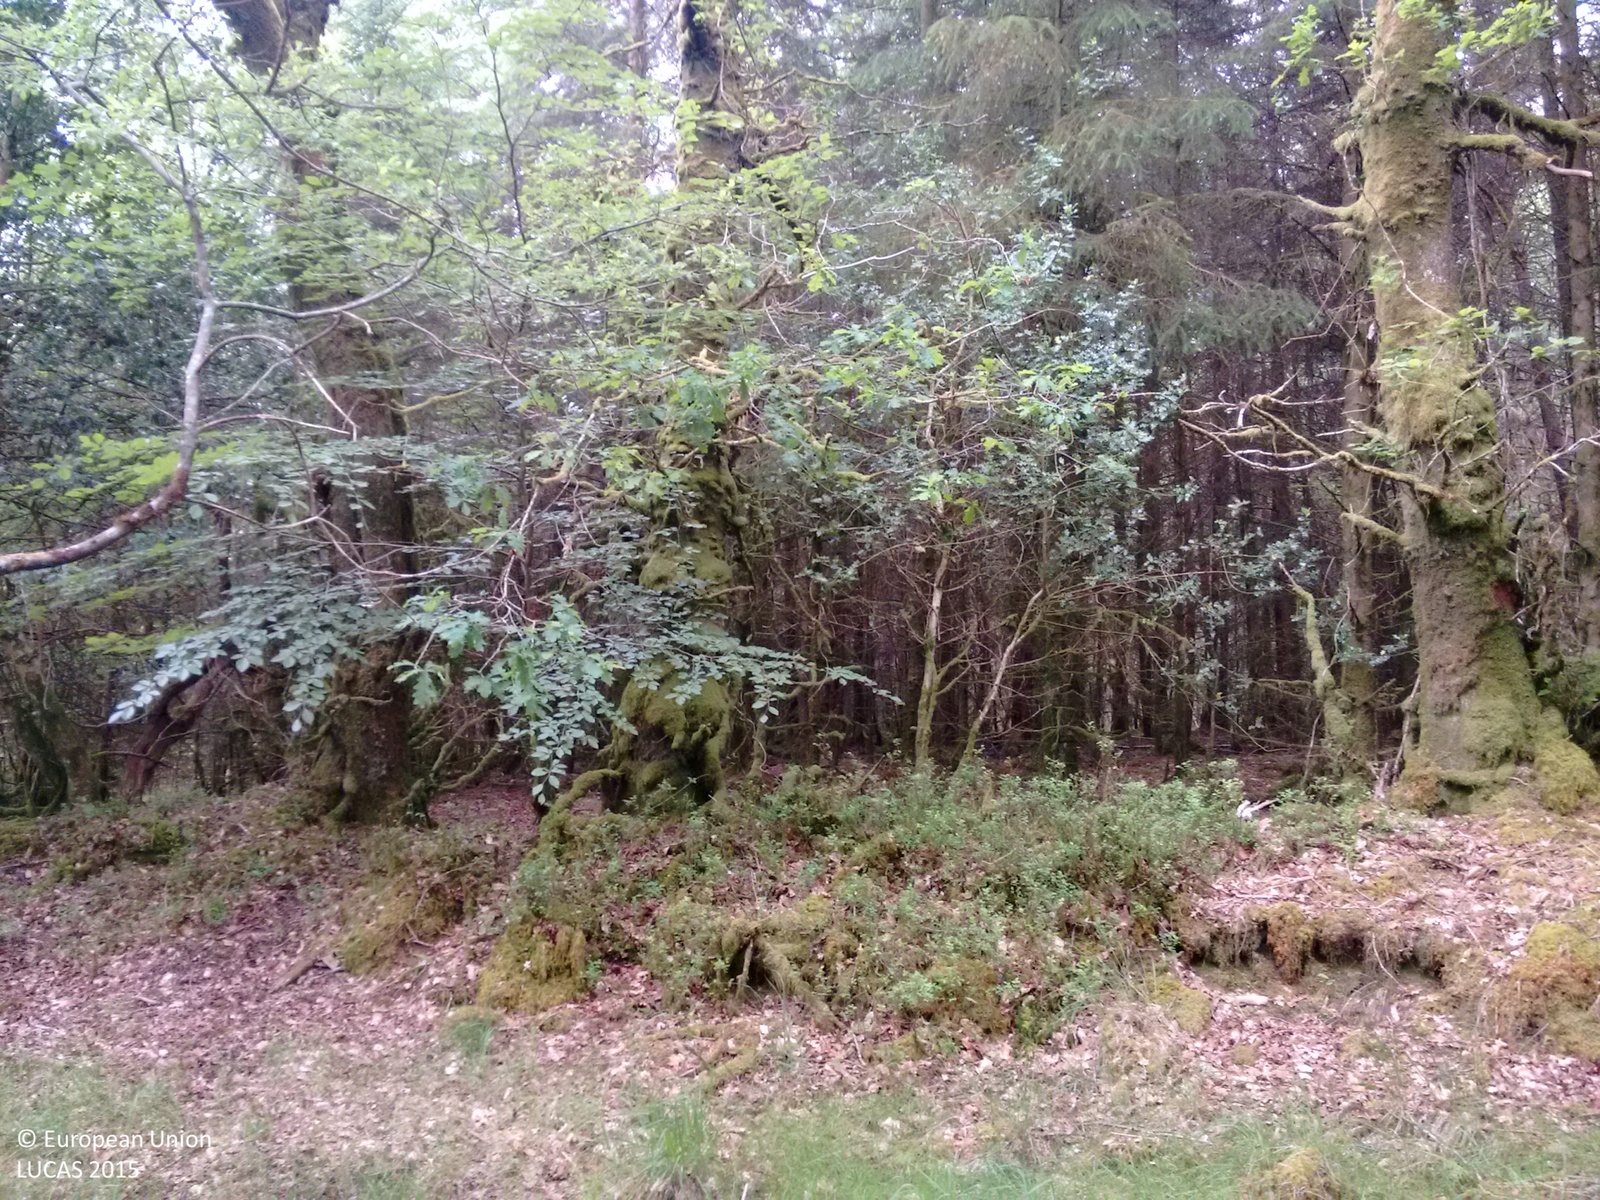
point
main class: Woodland
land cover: Spruce dominated mixed woodland
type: hemiboreal forest and nemoral coniferous forest and mixed broadleaved-coniferous forest
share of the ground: > 75 %
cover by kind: coniferous forest trees 50 %, broadleaved forest trees 25 %, lichens and mosses 15 %, herbaceous plants 5 %
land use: Forestry
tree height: > 5 m
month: June
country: IE
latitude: 53.0355
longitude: -8.4605
